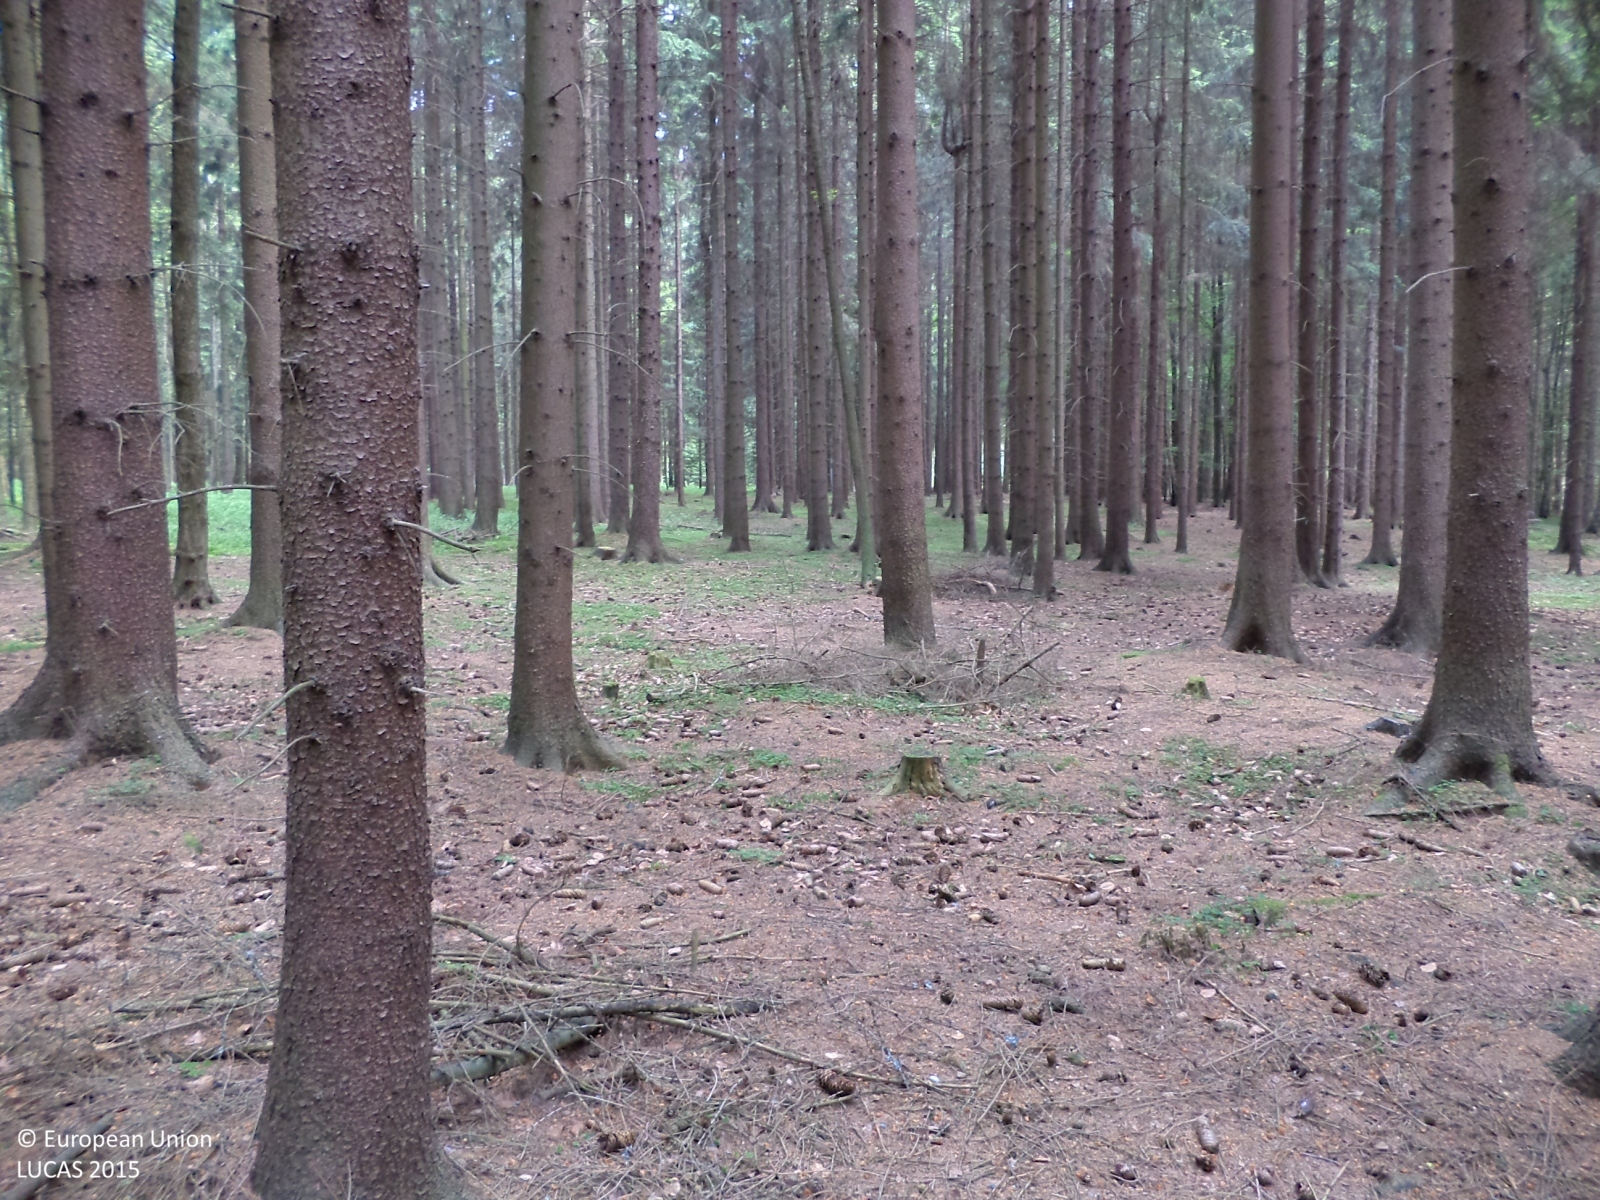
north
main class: Woodland
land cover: Spruce dominated coniferous woodland
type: hemiboreal forest and nemoral coniferous forest and mixed broadleaved-coniferous forest
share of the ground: > 75 %
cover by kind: coniferous forest trees 90 %, shrubs 5 %, lichens and mosses 5 %
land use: Forestry
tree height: > 5 m
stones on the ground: < 10 %
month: June
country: CZ
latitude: 49.5189
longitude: 14.9337
